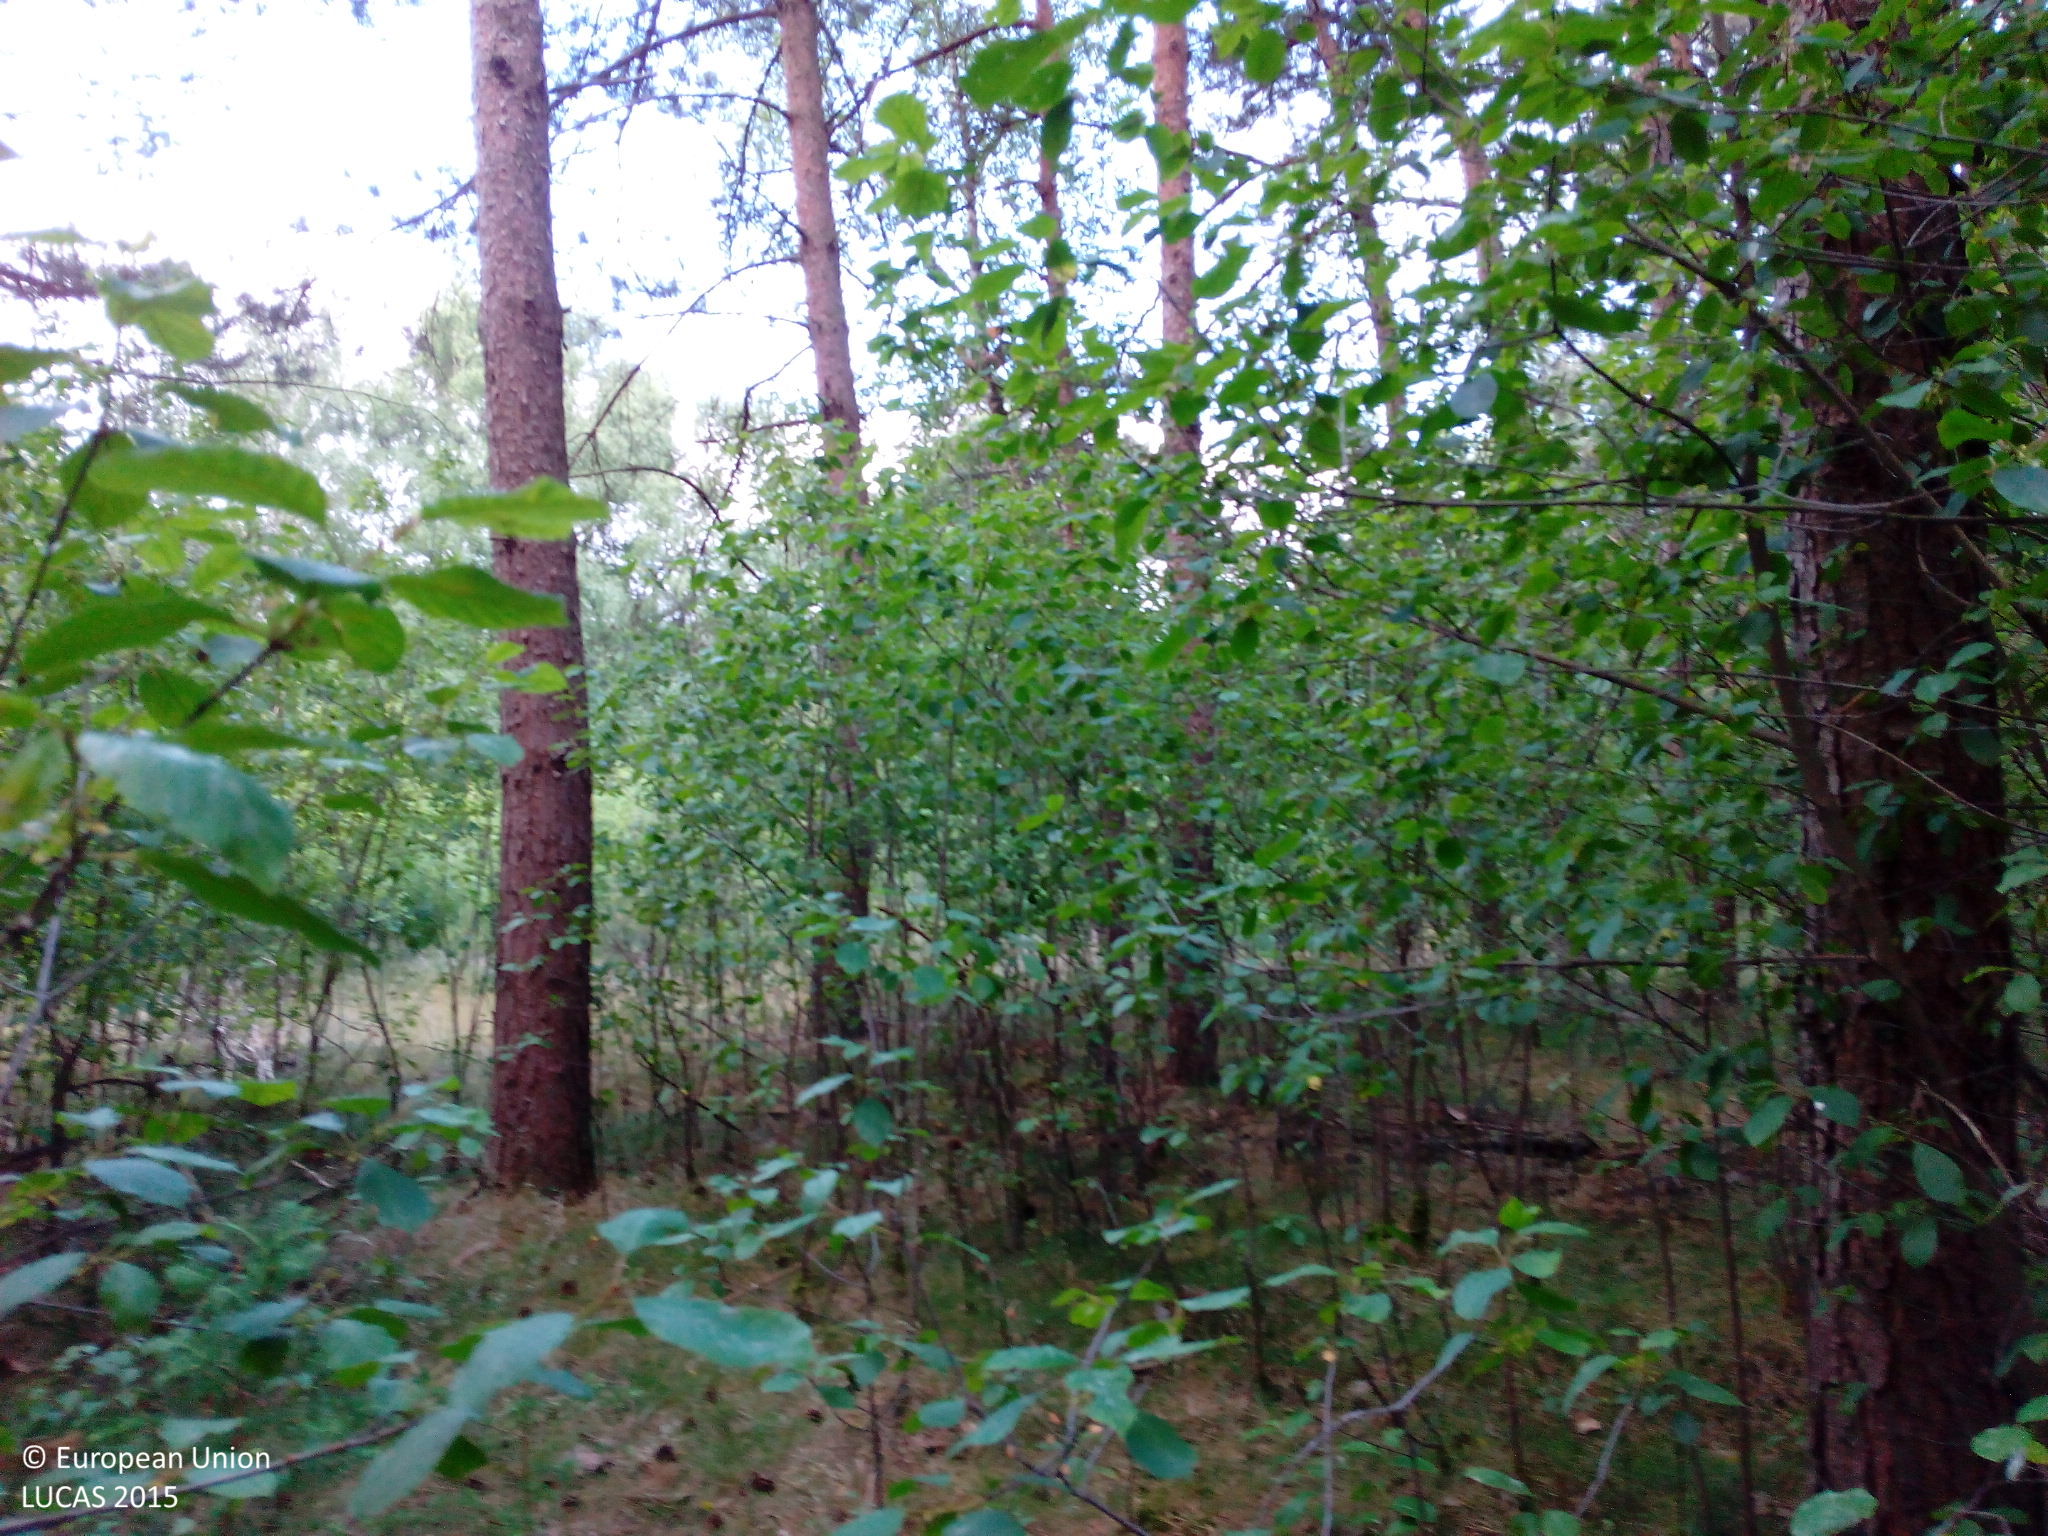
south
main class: Woodland
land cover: Pine dominated coniferous woodland
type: hemiboreal forest and nemoral coniferous forest and mixed broadleaved-coniferous forest
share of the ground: 50 - 75 %
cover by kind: coniferous forest trees 70 %, shrubs 15 %, herbaceous plants 10 %, broadleaved forest trees 5 %
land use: Forestry
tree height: > 5 m
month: June
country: DE
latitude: 52.6371
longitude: 7.4145
